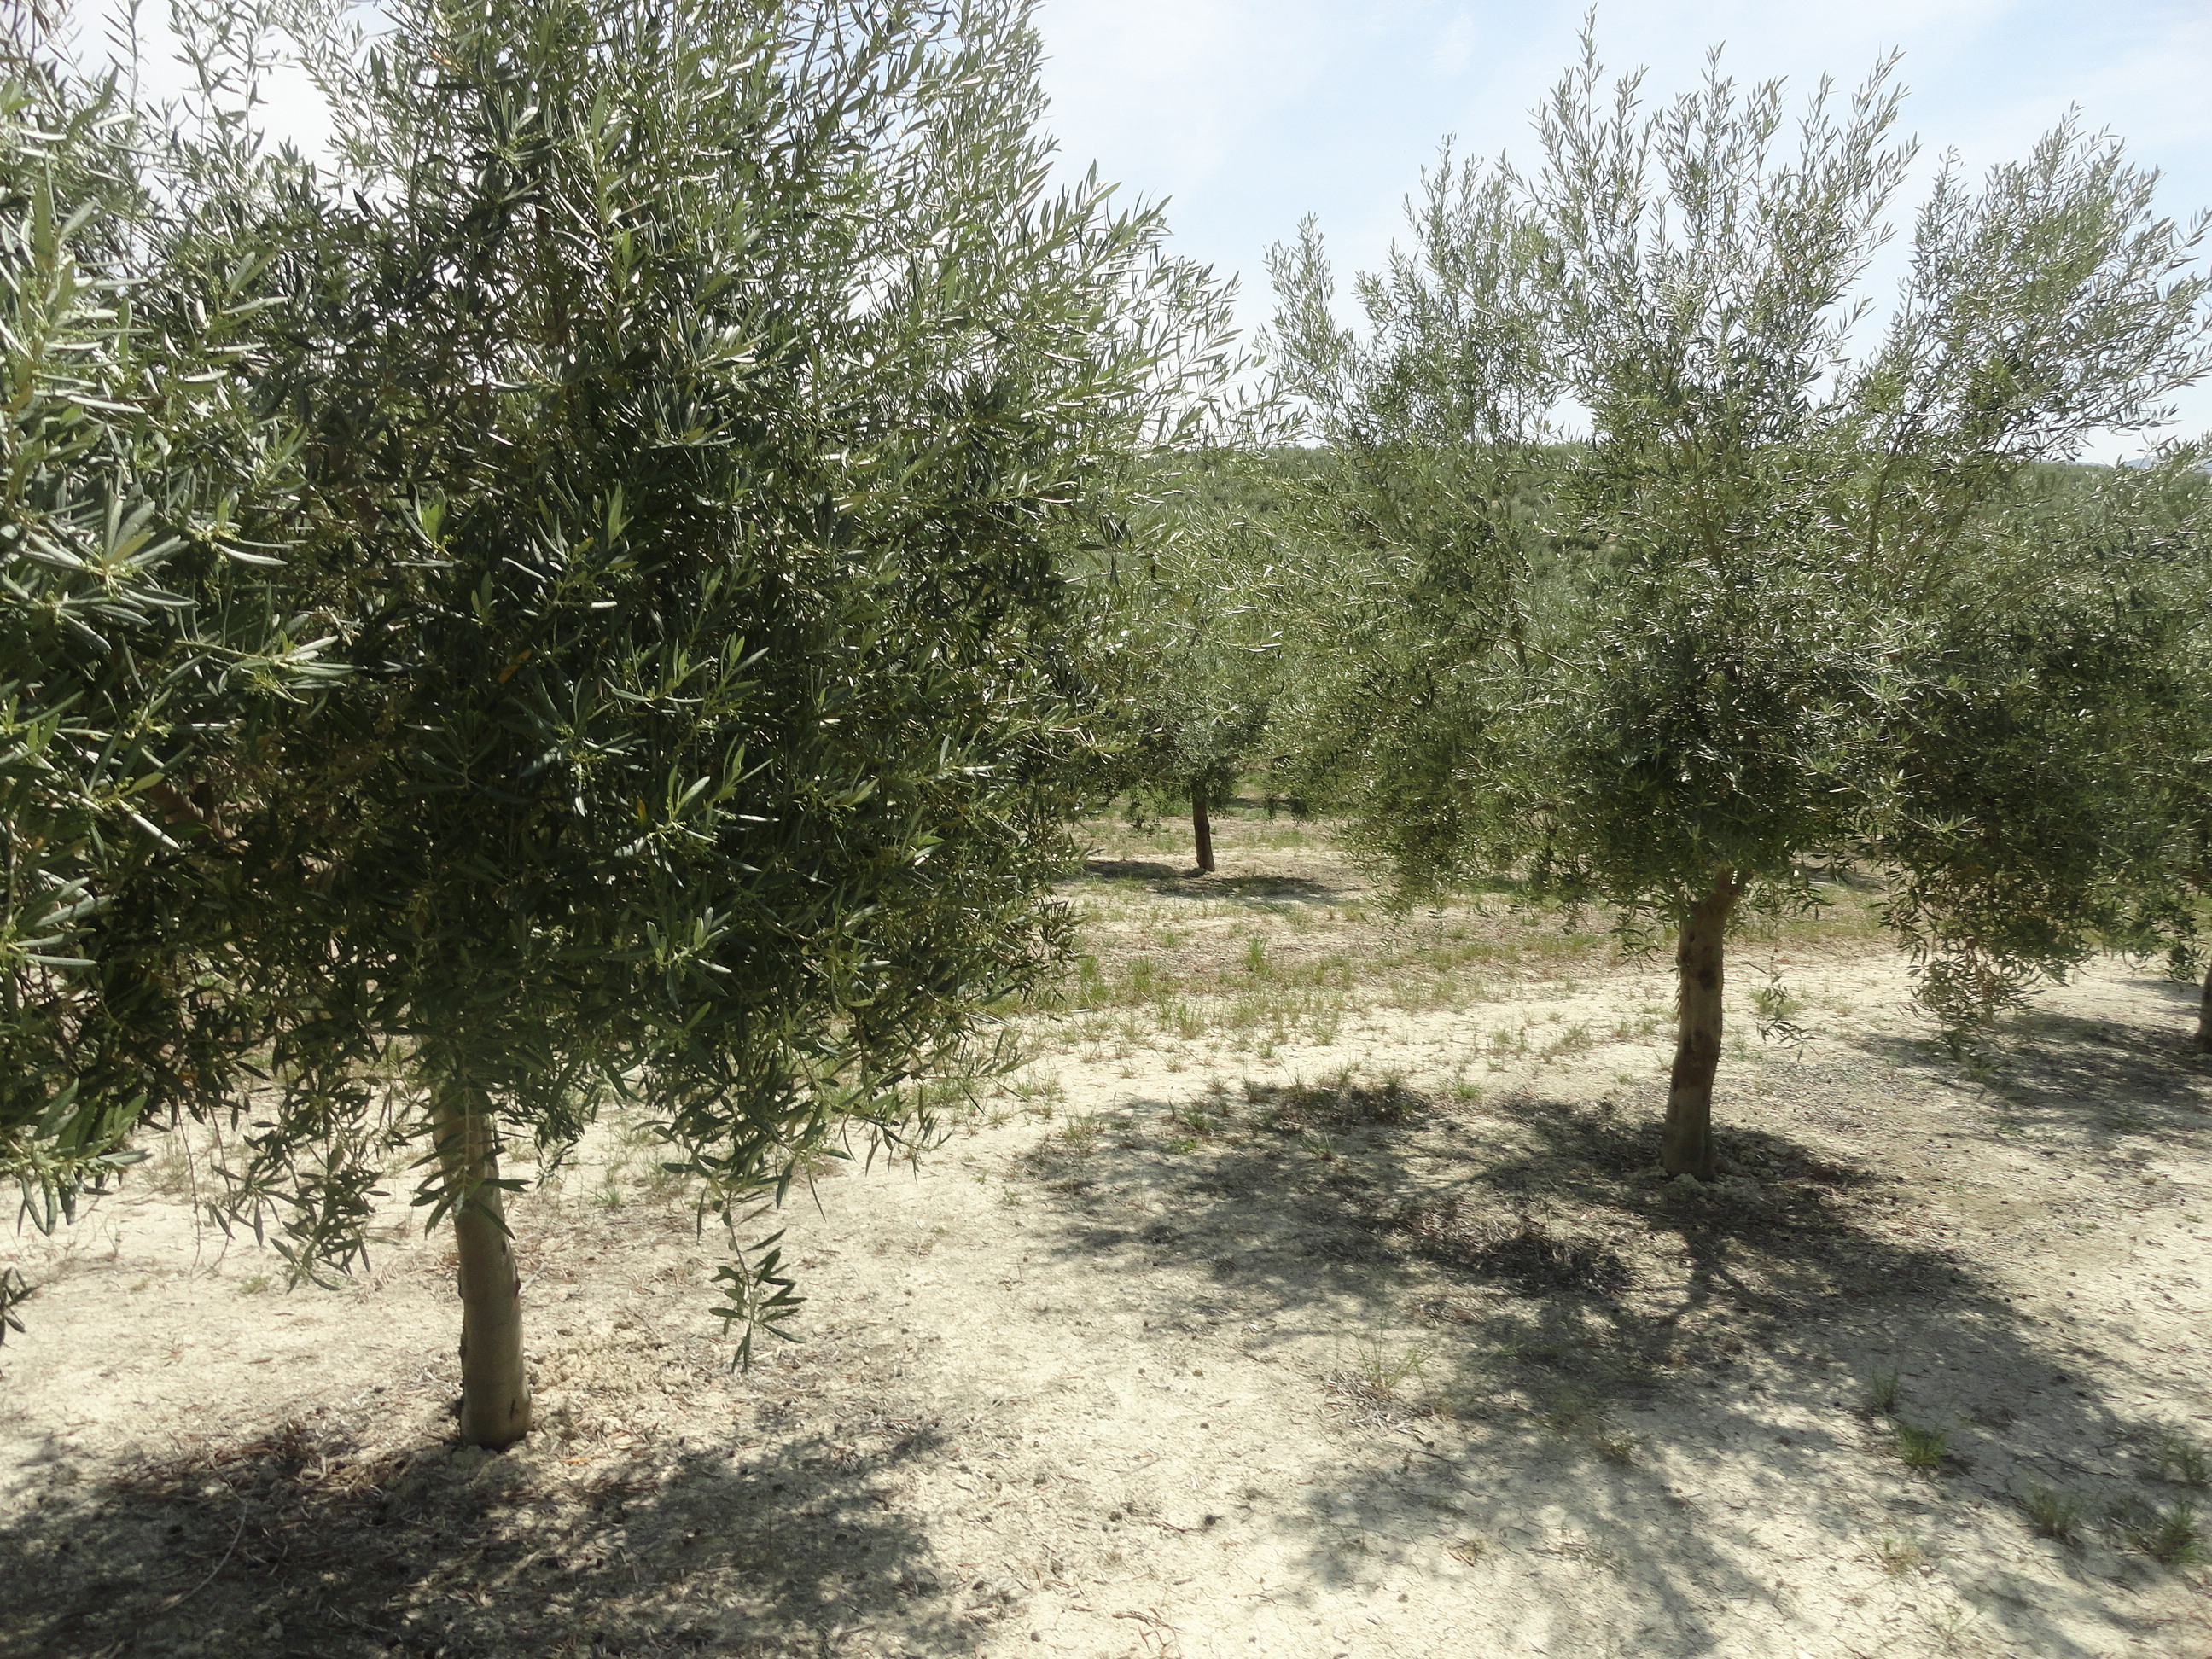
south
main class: Cropland
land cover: Olive groves
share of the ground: 50 - 75 %
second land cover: Spontaneously vegetated surfaces
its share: 10 - 25 %
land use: Agriculture (excluding fallow land and kitchen gardens)
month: April
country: ES
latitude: 37.6189
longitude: -4.4050
